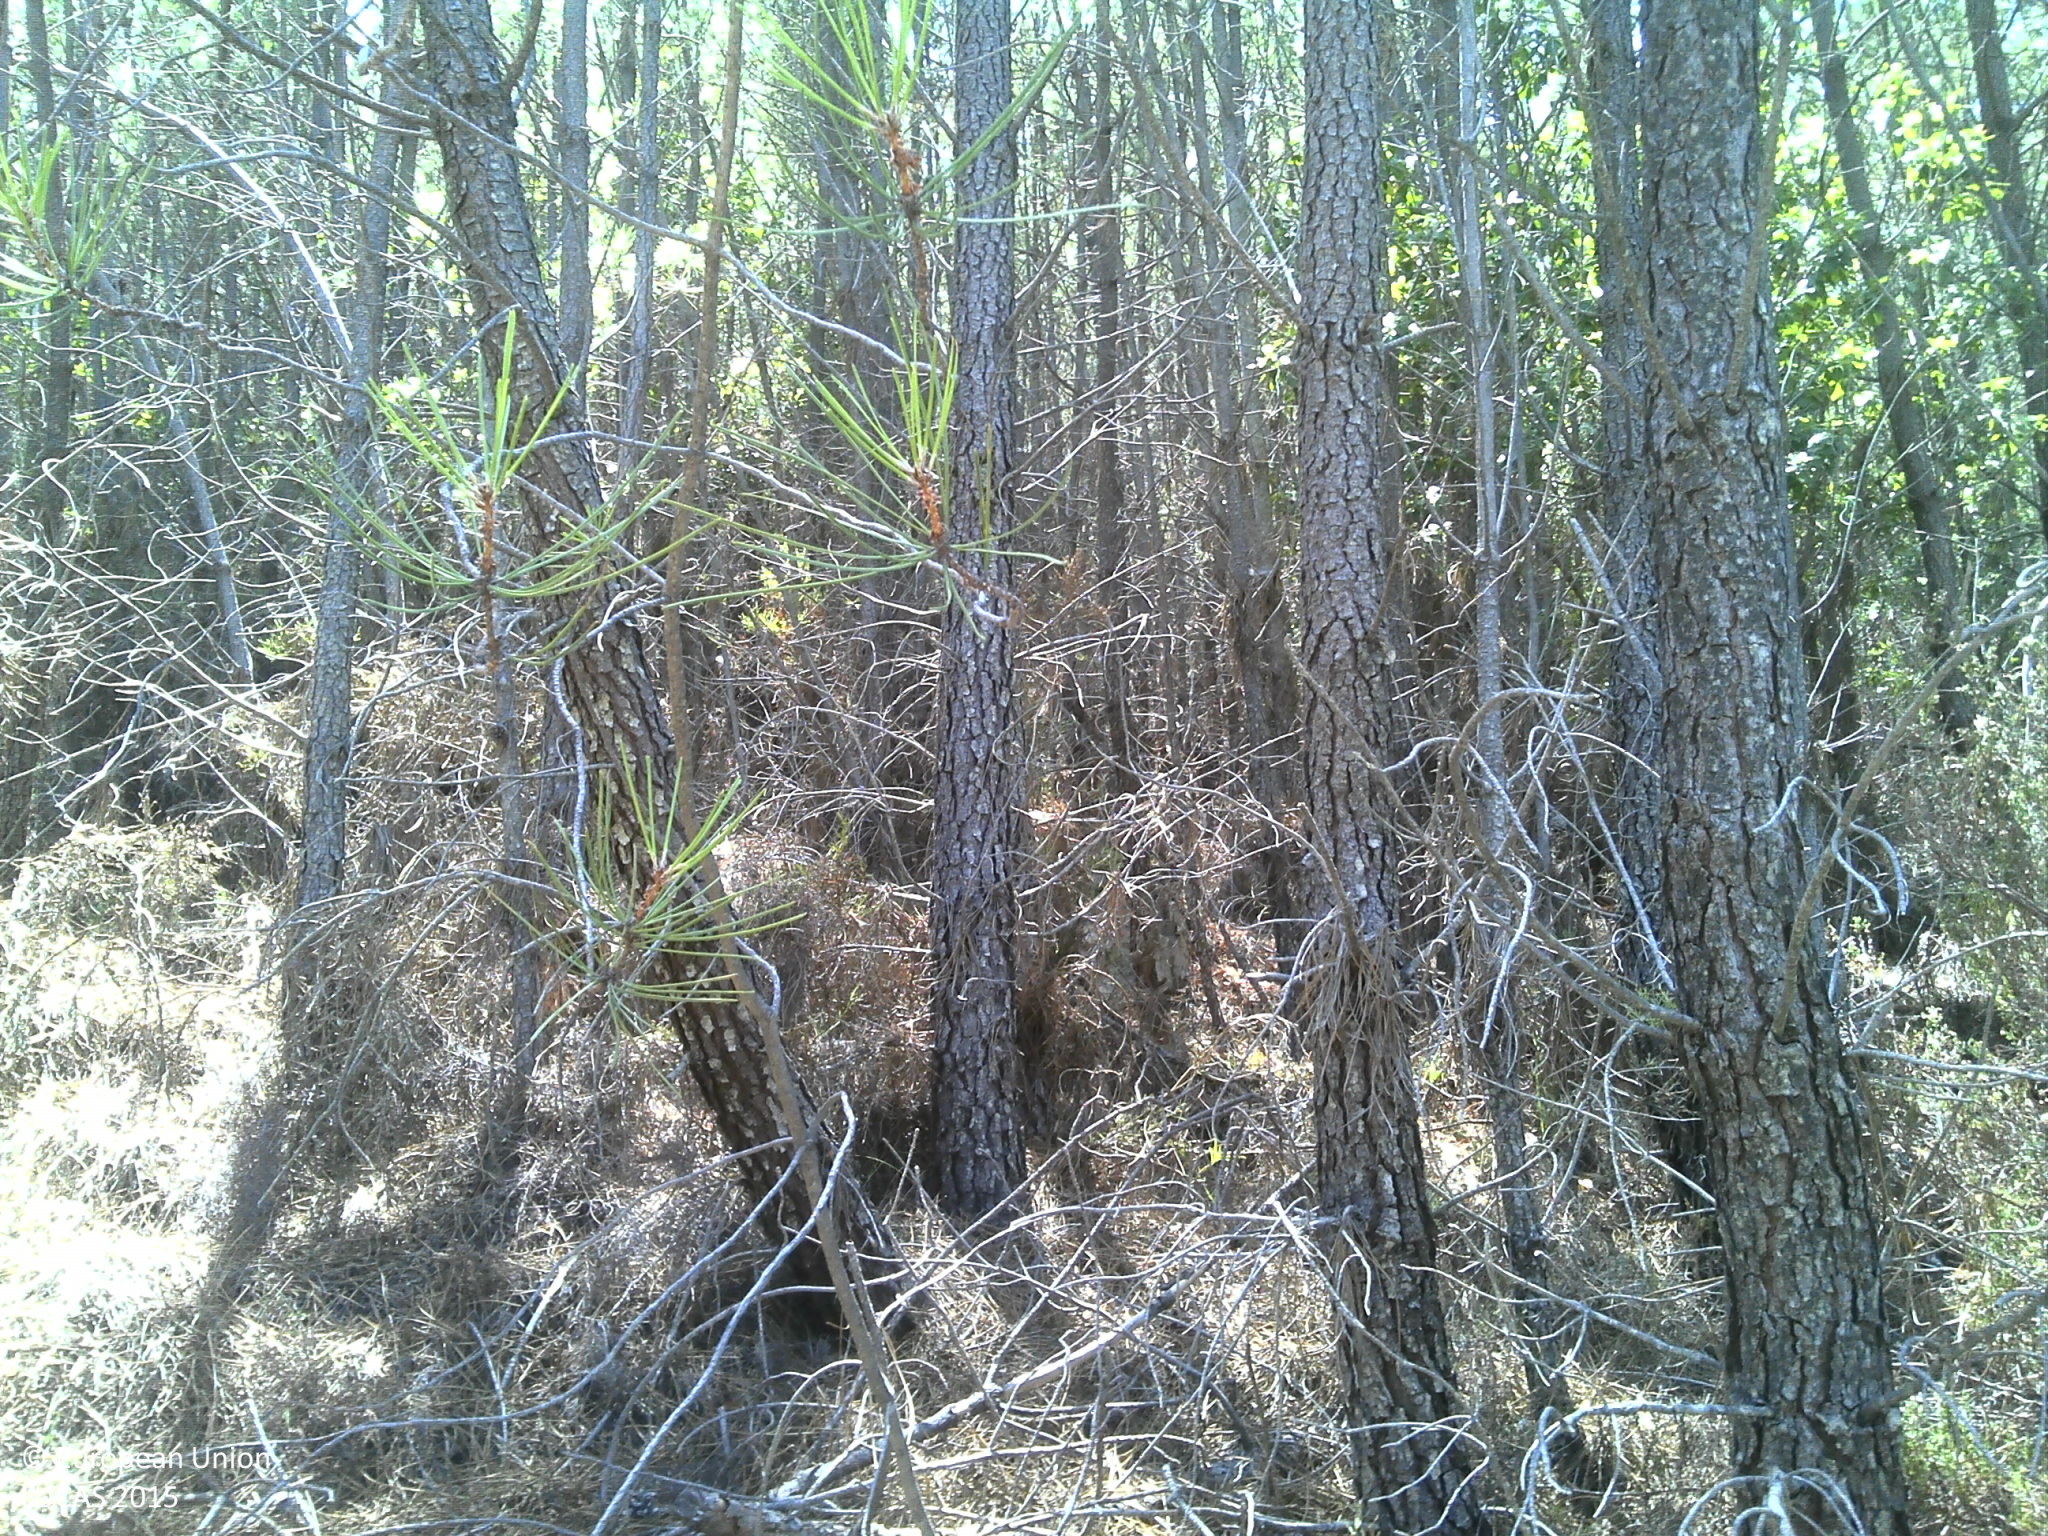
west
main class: Woodland
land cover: Pine dominated coniferous woodland
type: coniferous forest of the mediterranean region
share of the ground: 50 - 75 %
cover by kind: coniferous forest trees 75 %, shrubs 20 %
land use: Forestry
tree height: > 5 m
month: July
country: PT
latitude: 39.9287
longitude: -7.7407
